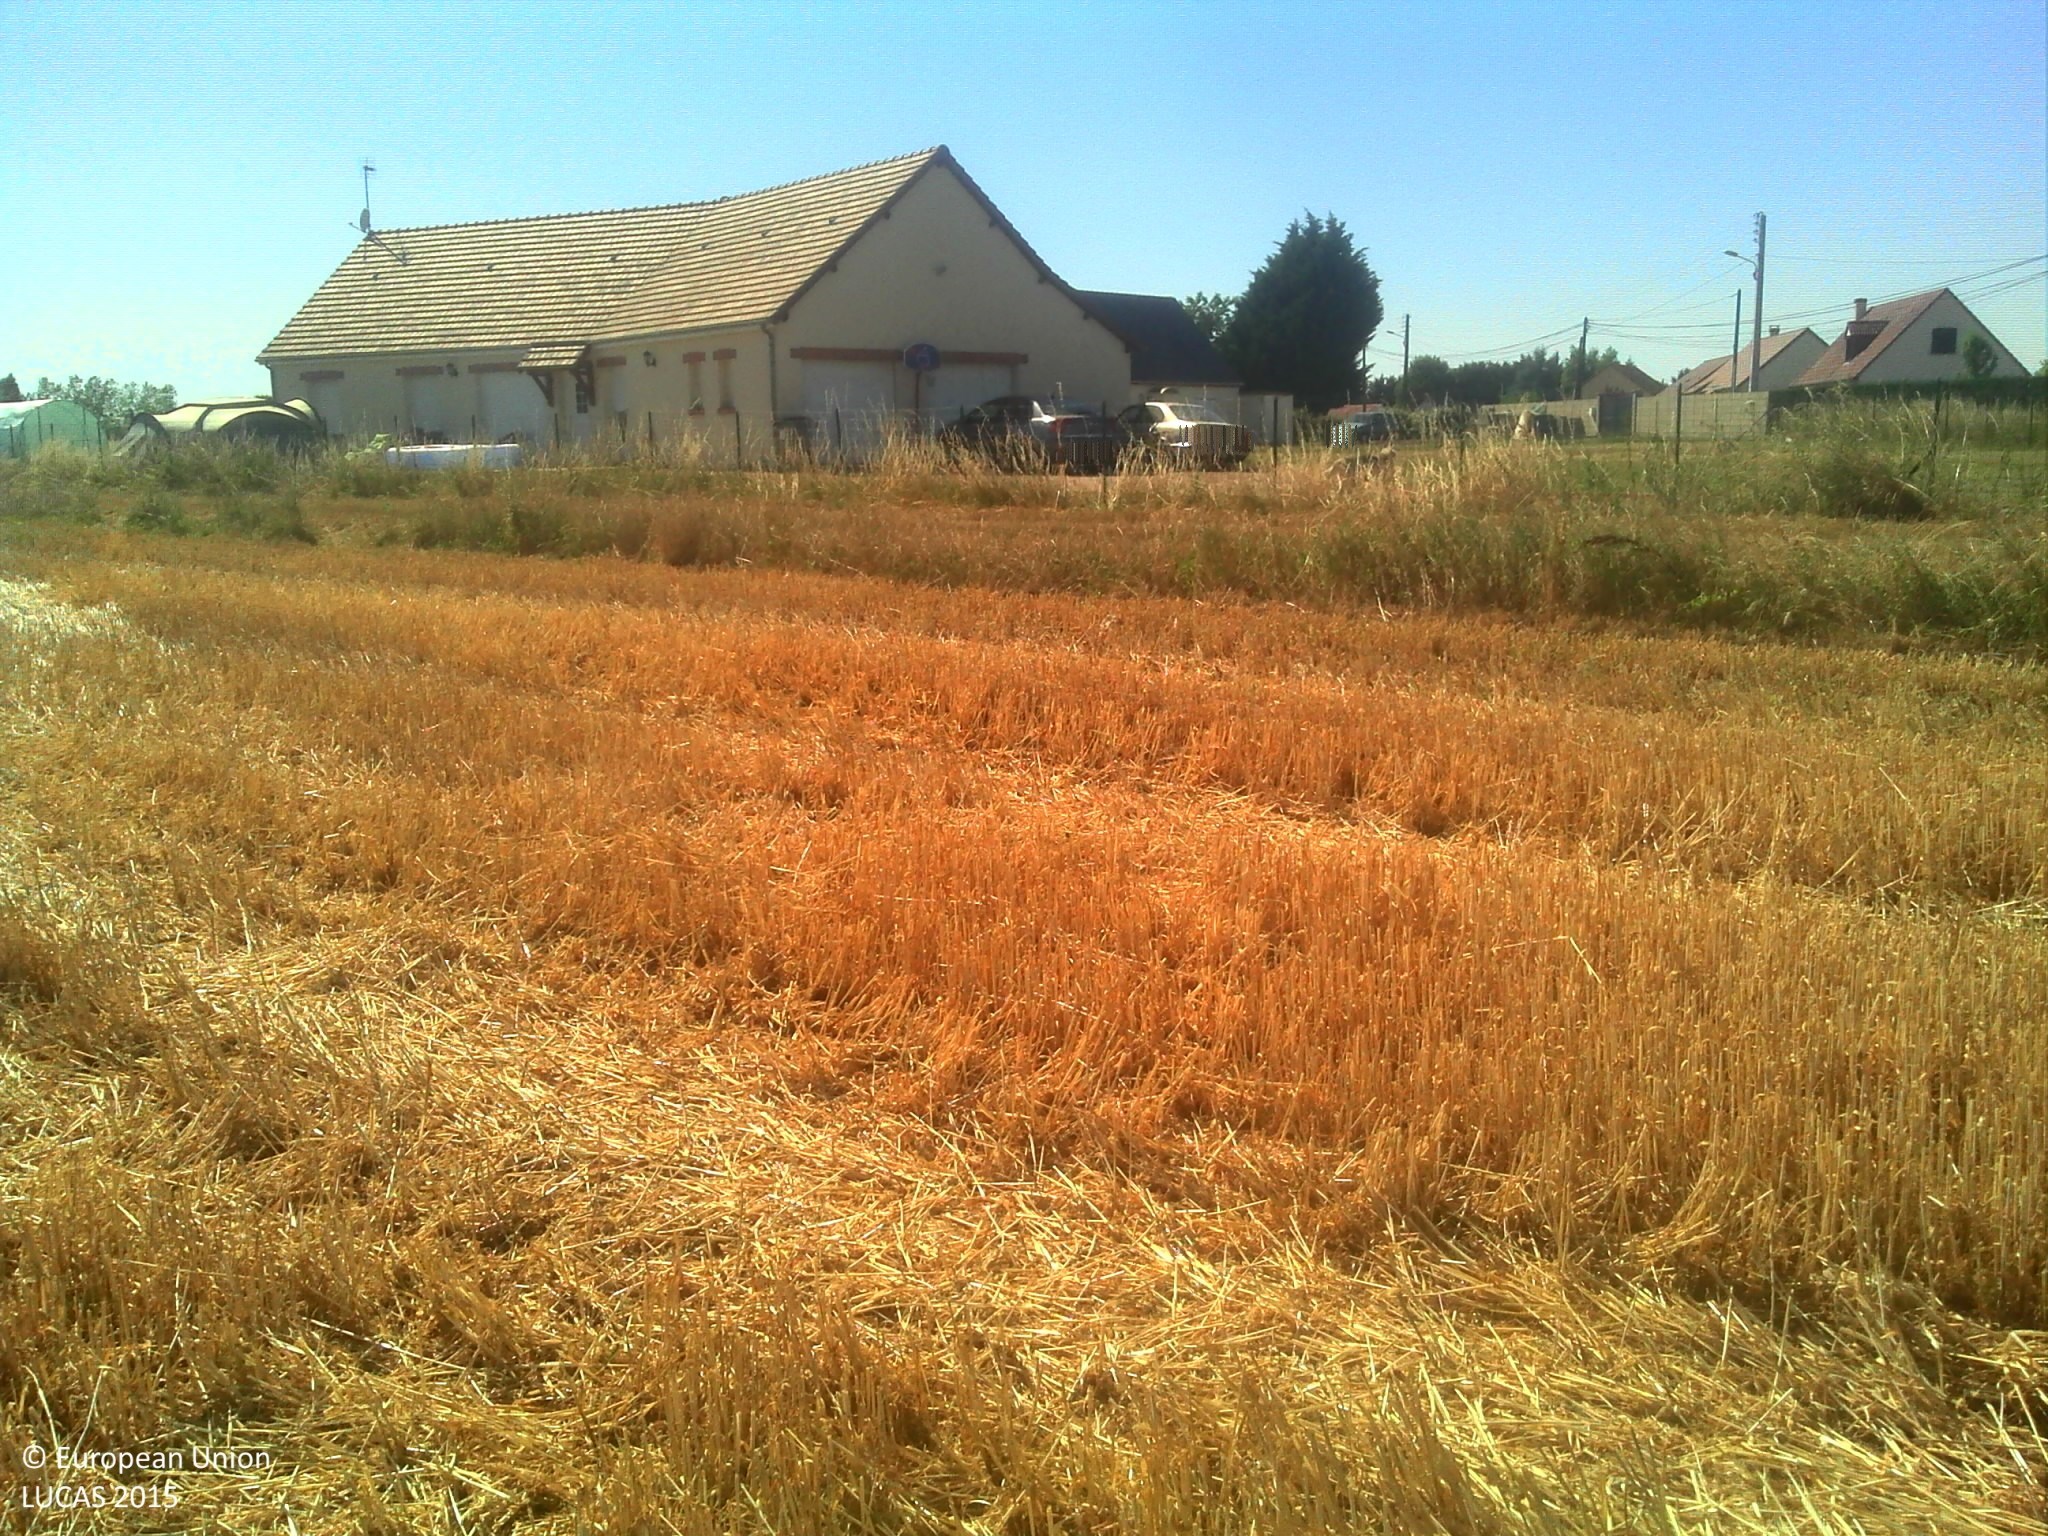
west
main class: Cropland
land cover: Barley
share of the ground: > 75 %
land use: Agriculture (excluding fallow land and kitchen gardens)
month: June
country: FR
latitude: 47.3300
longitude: 1.4513
